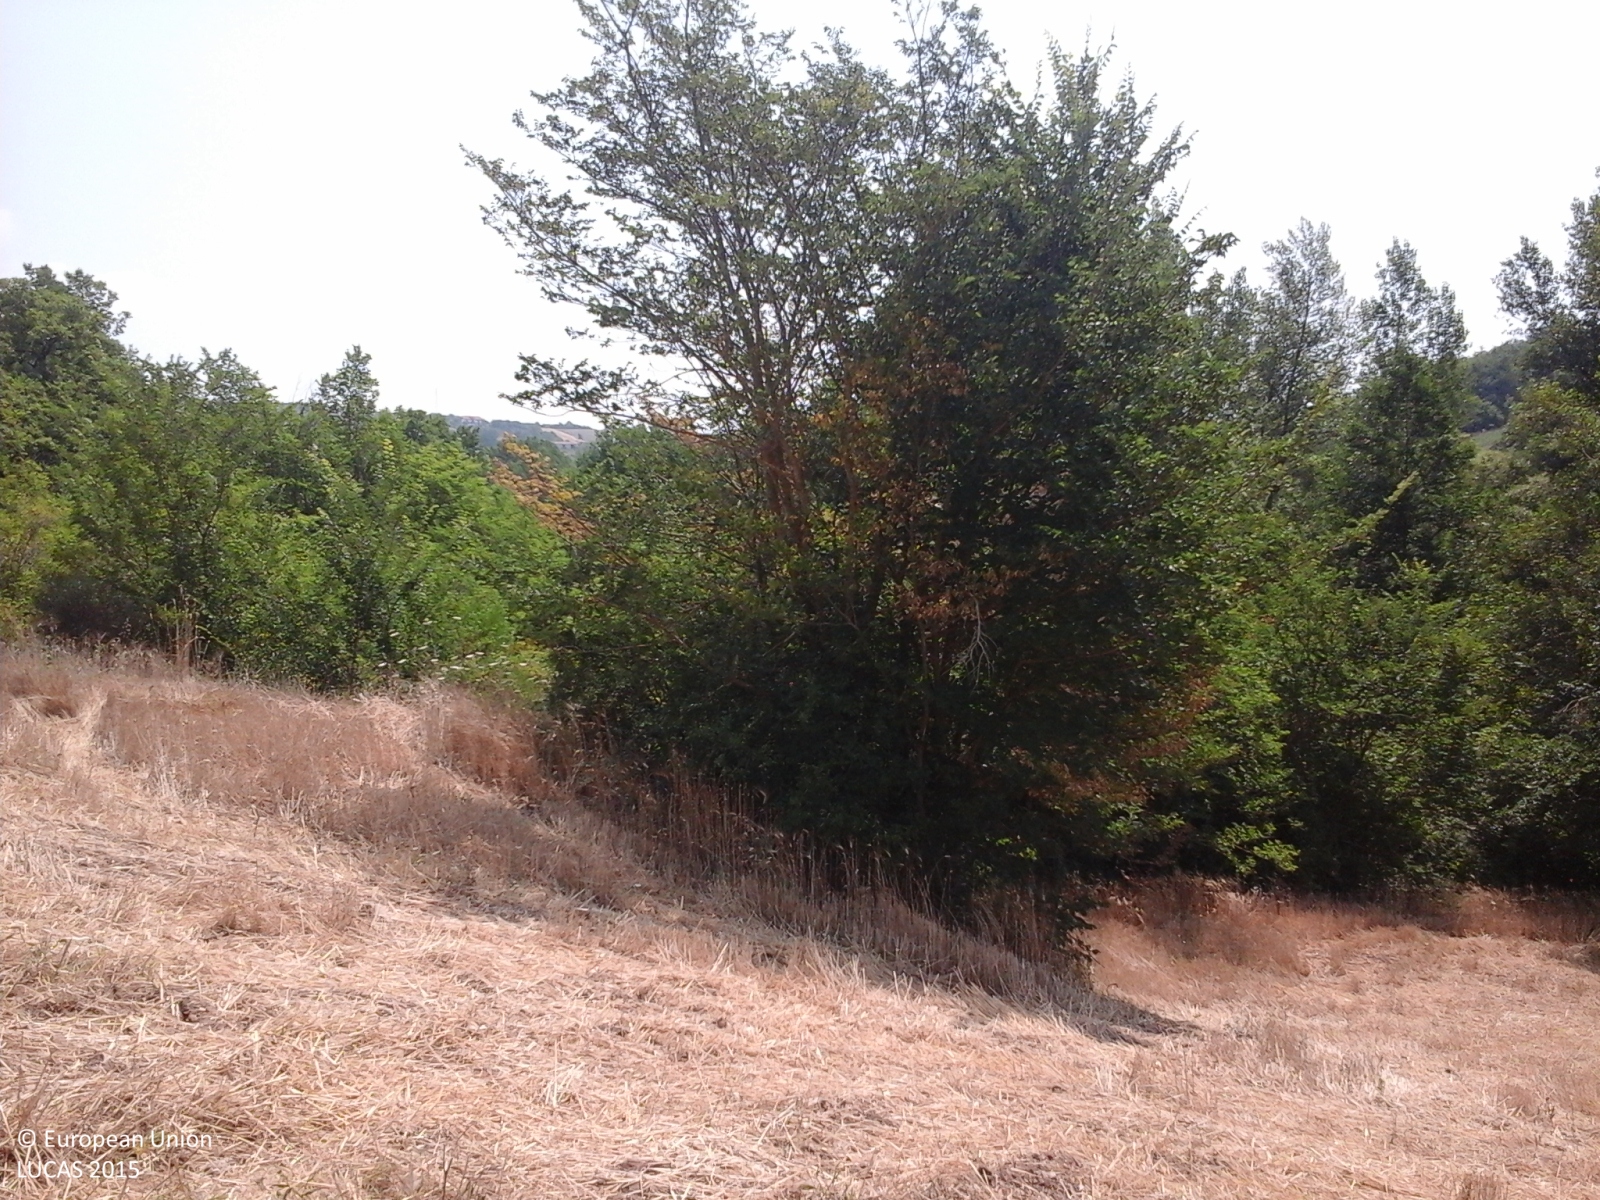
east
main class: Cropland
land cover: Common wheat
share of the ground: > 75 %
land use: Agriculture (excluding fallow land and kitchen gardens)
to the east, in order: Common wheat; Broadleaved woodland; Shrubland without tree cover; Shrubland with sparse tree cover
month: July
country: IT
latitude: 40.9491
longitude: 15.1241
